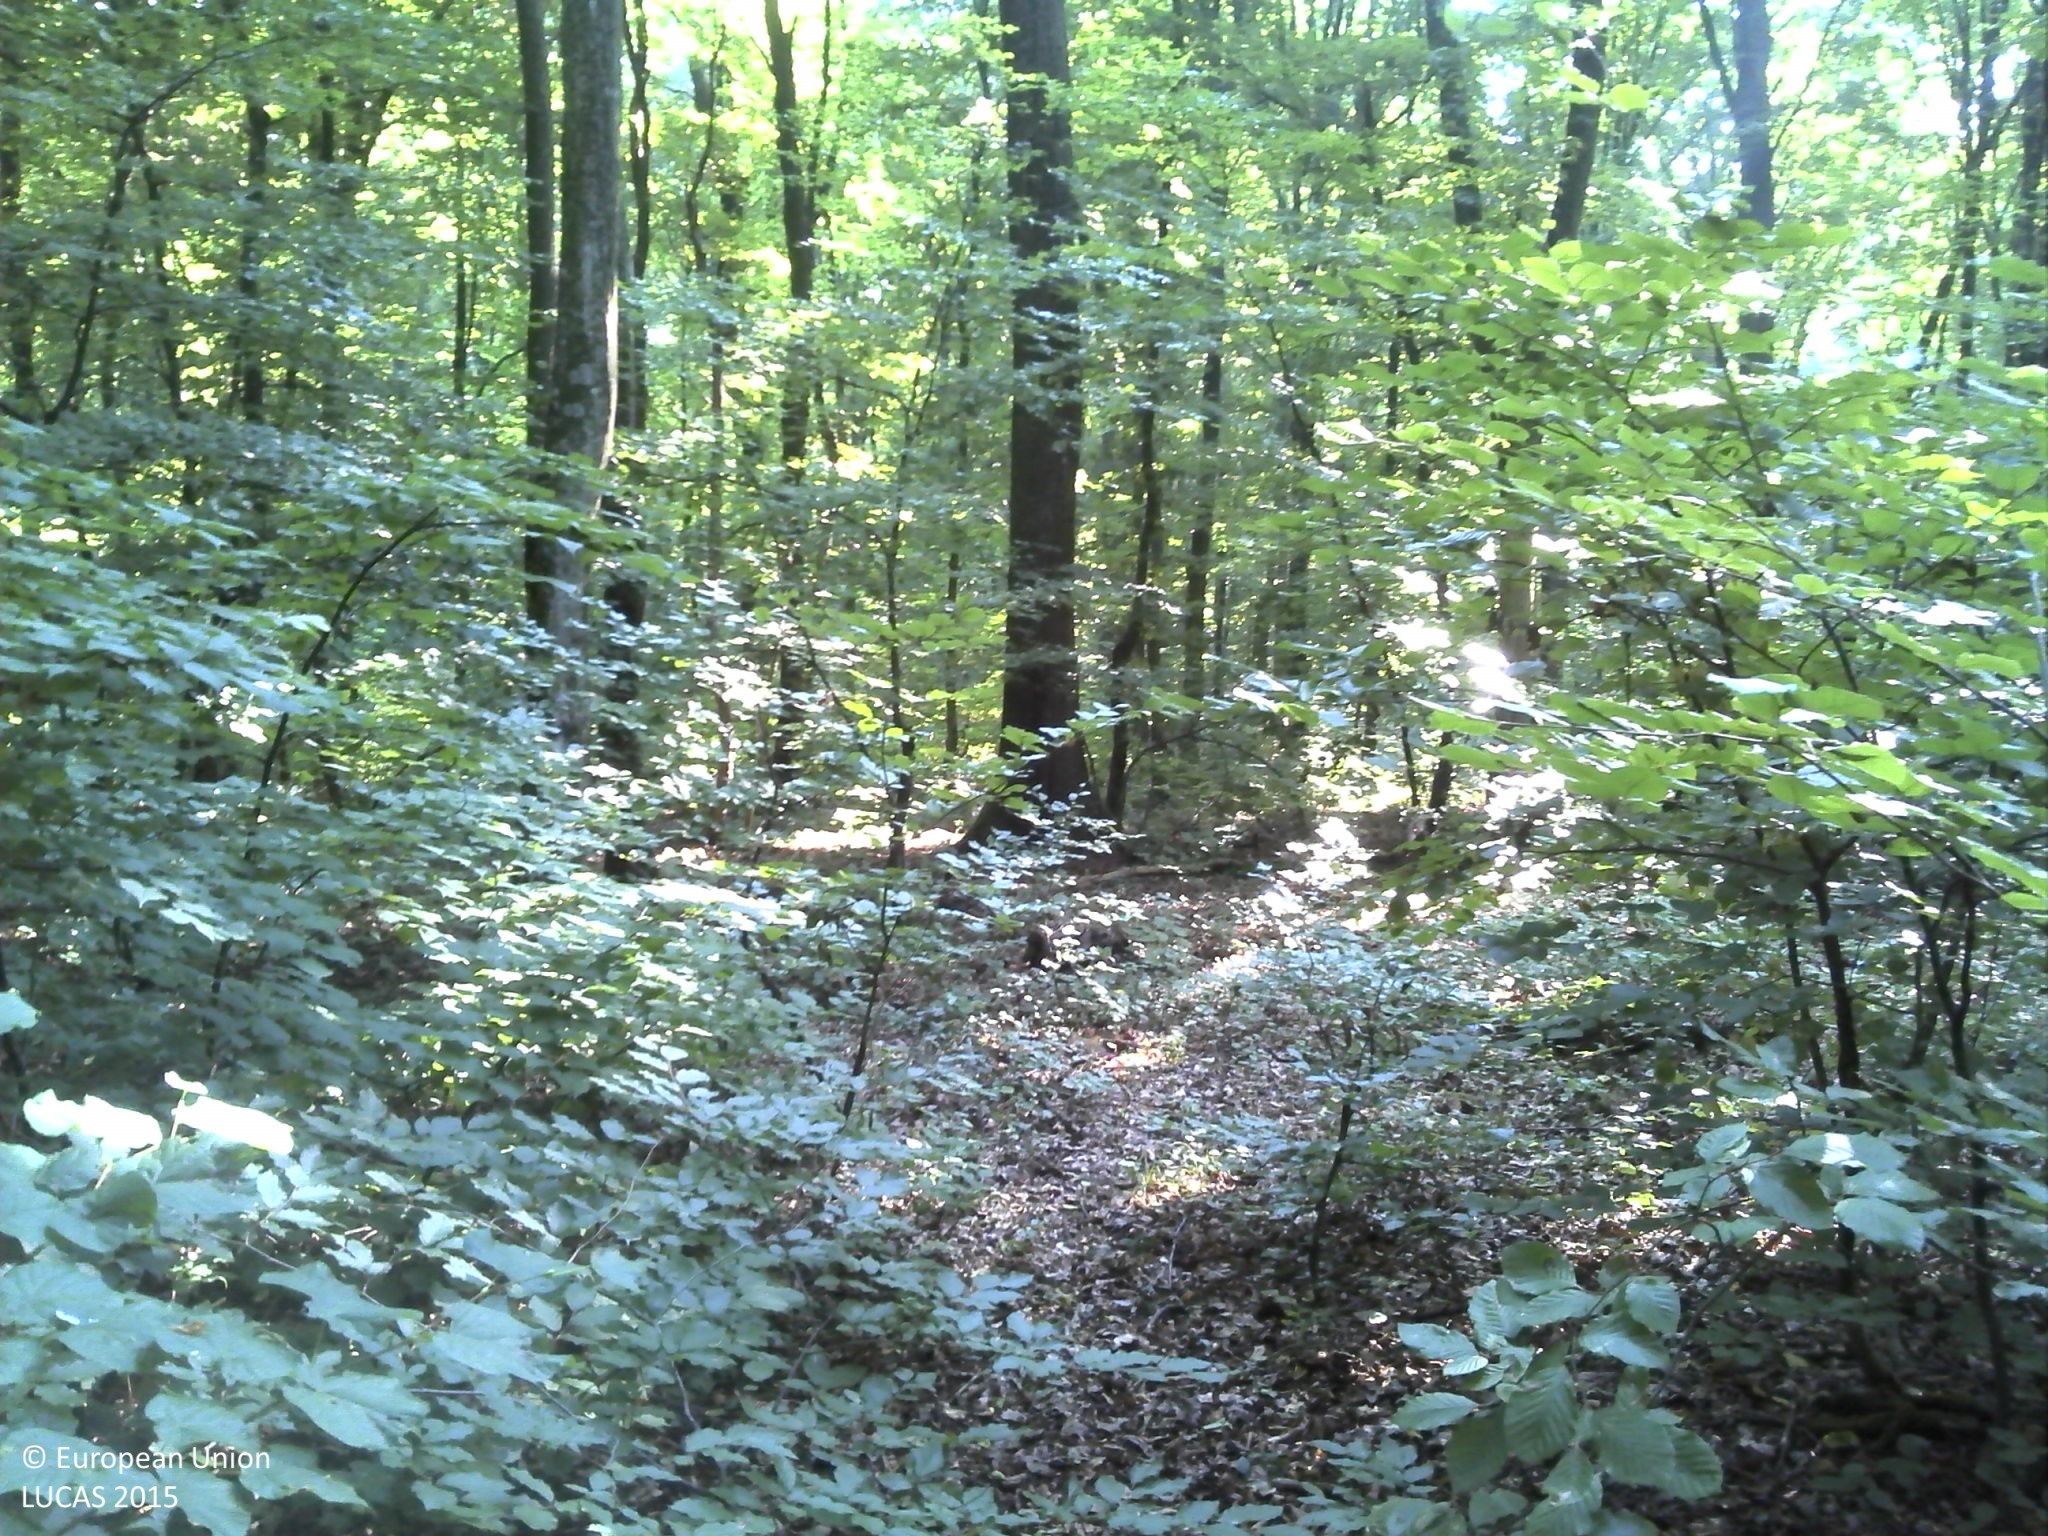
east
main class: Woodland
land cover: Broadleaved woodland
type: acidophilous oak and oak-birch forest
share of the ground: > 75 %
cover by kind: broadleaved forest trees 90 %, shrubs 5 %, herbaceous plants 5 %
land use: Forestry
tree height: > 5 m
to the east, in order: Broadleaved woodland; Tracks; Broadleaved woodland; Ditches and canals; Broadleaved woodland
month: July
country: HR
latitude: 45.9752
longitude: 16.7506
